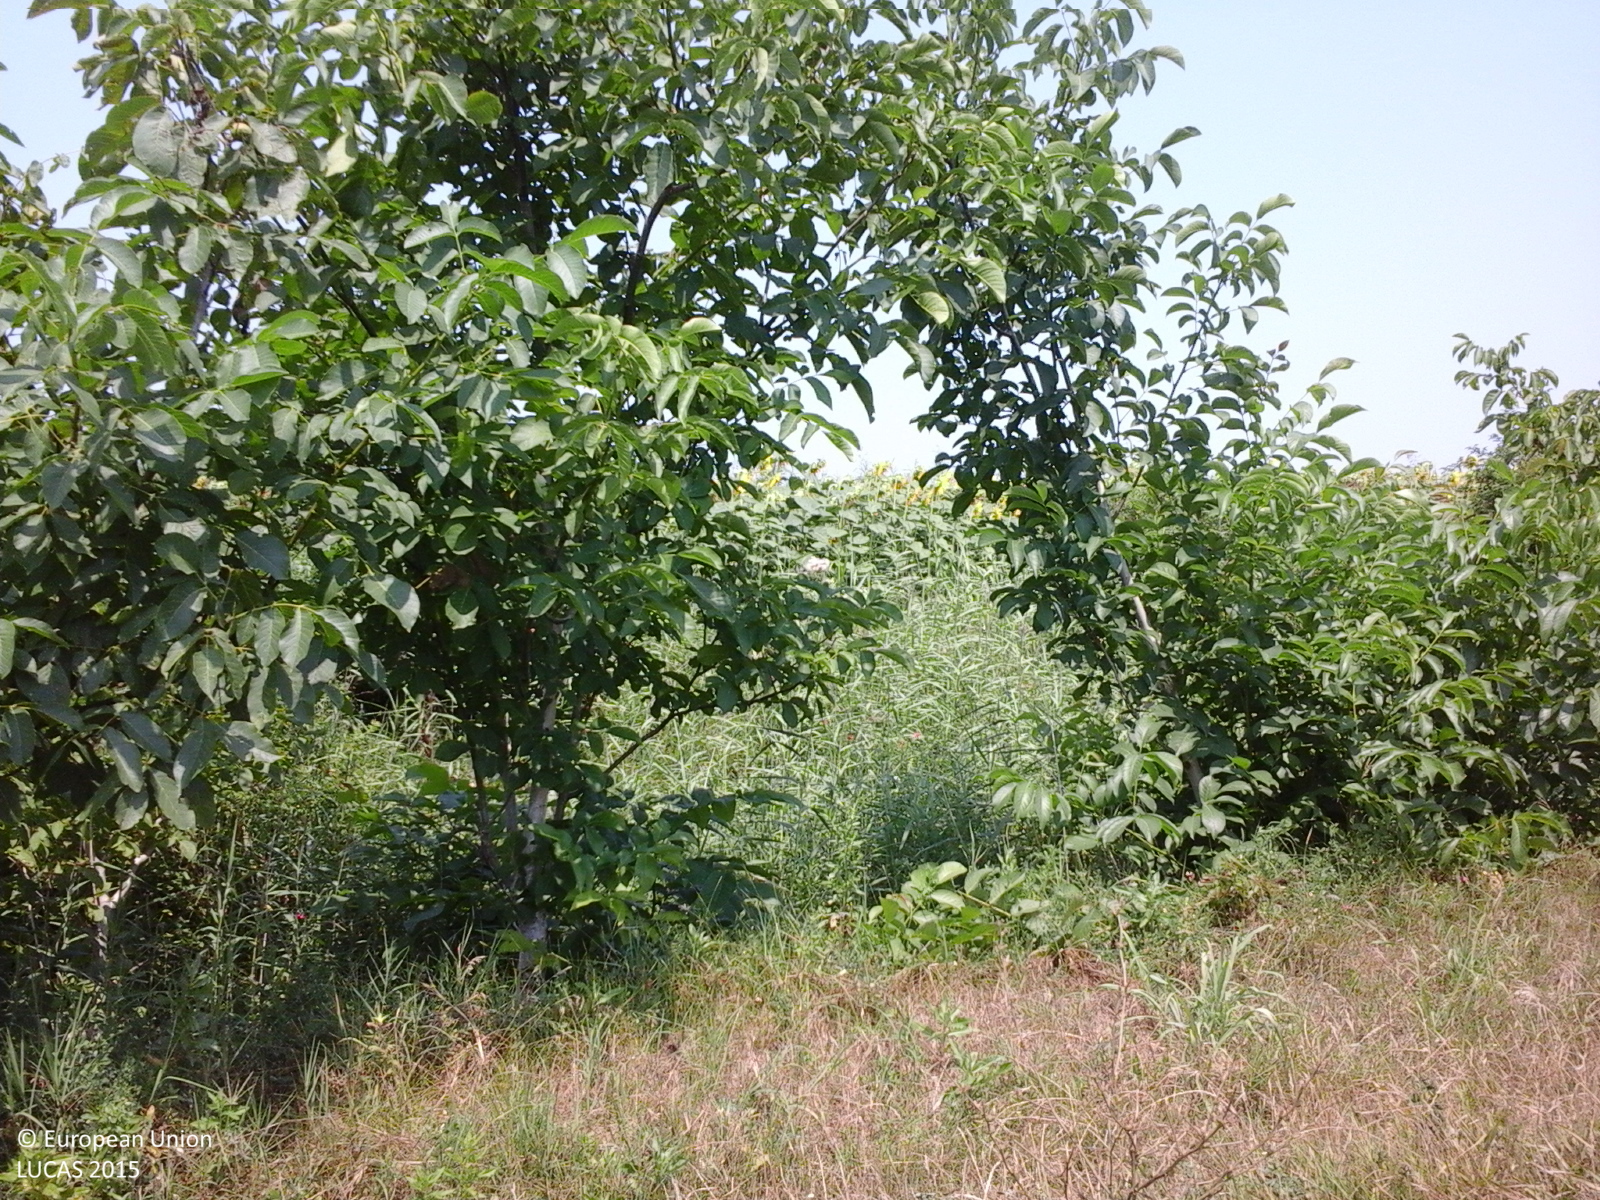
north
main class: Cropland
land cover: Sunflower
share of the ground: > 75 %
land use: Agriculture (excluding fallow land and kitchen gardens)
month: July
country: RO
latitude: 44.7251
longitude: 26.2860
